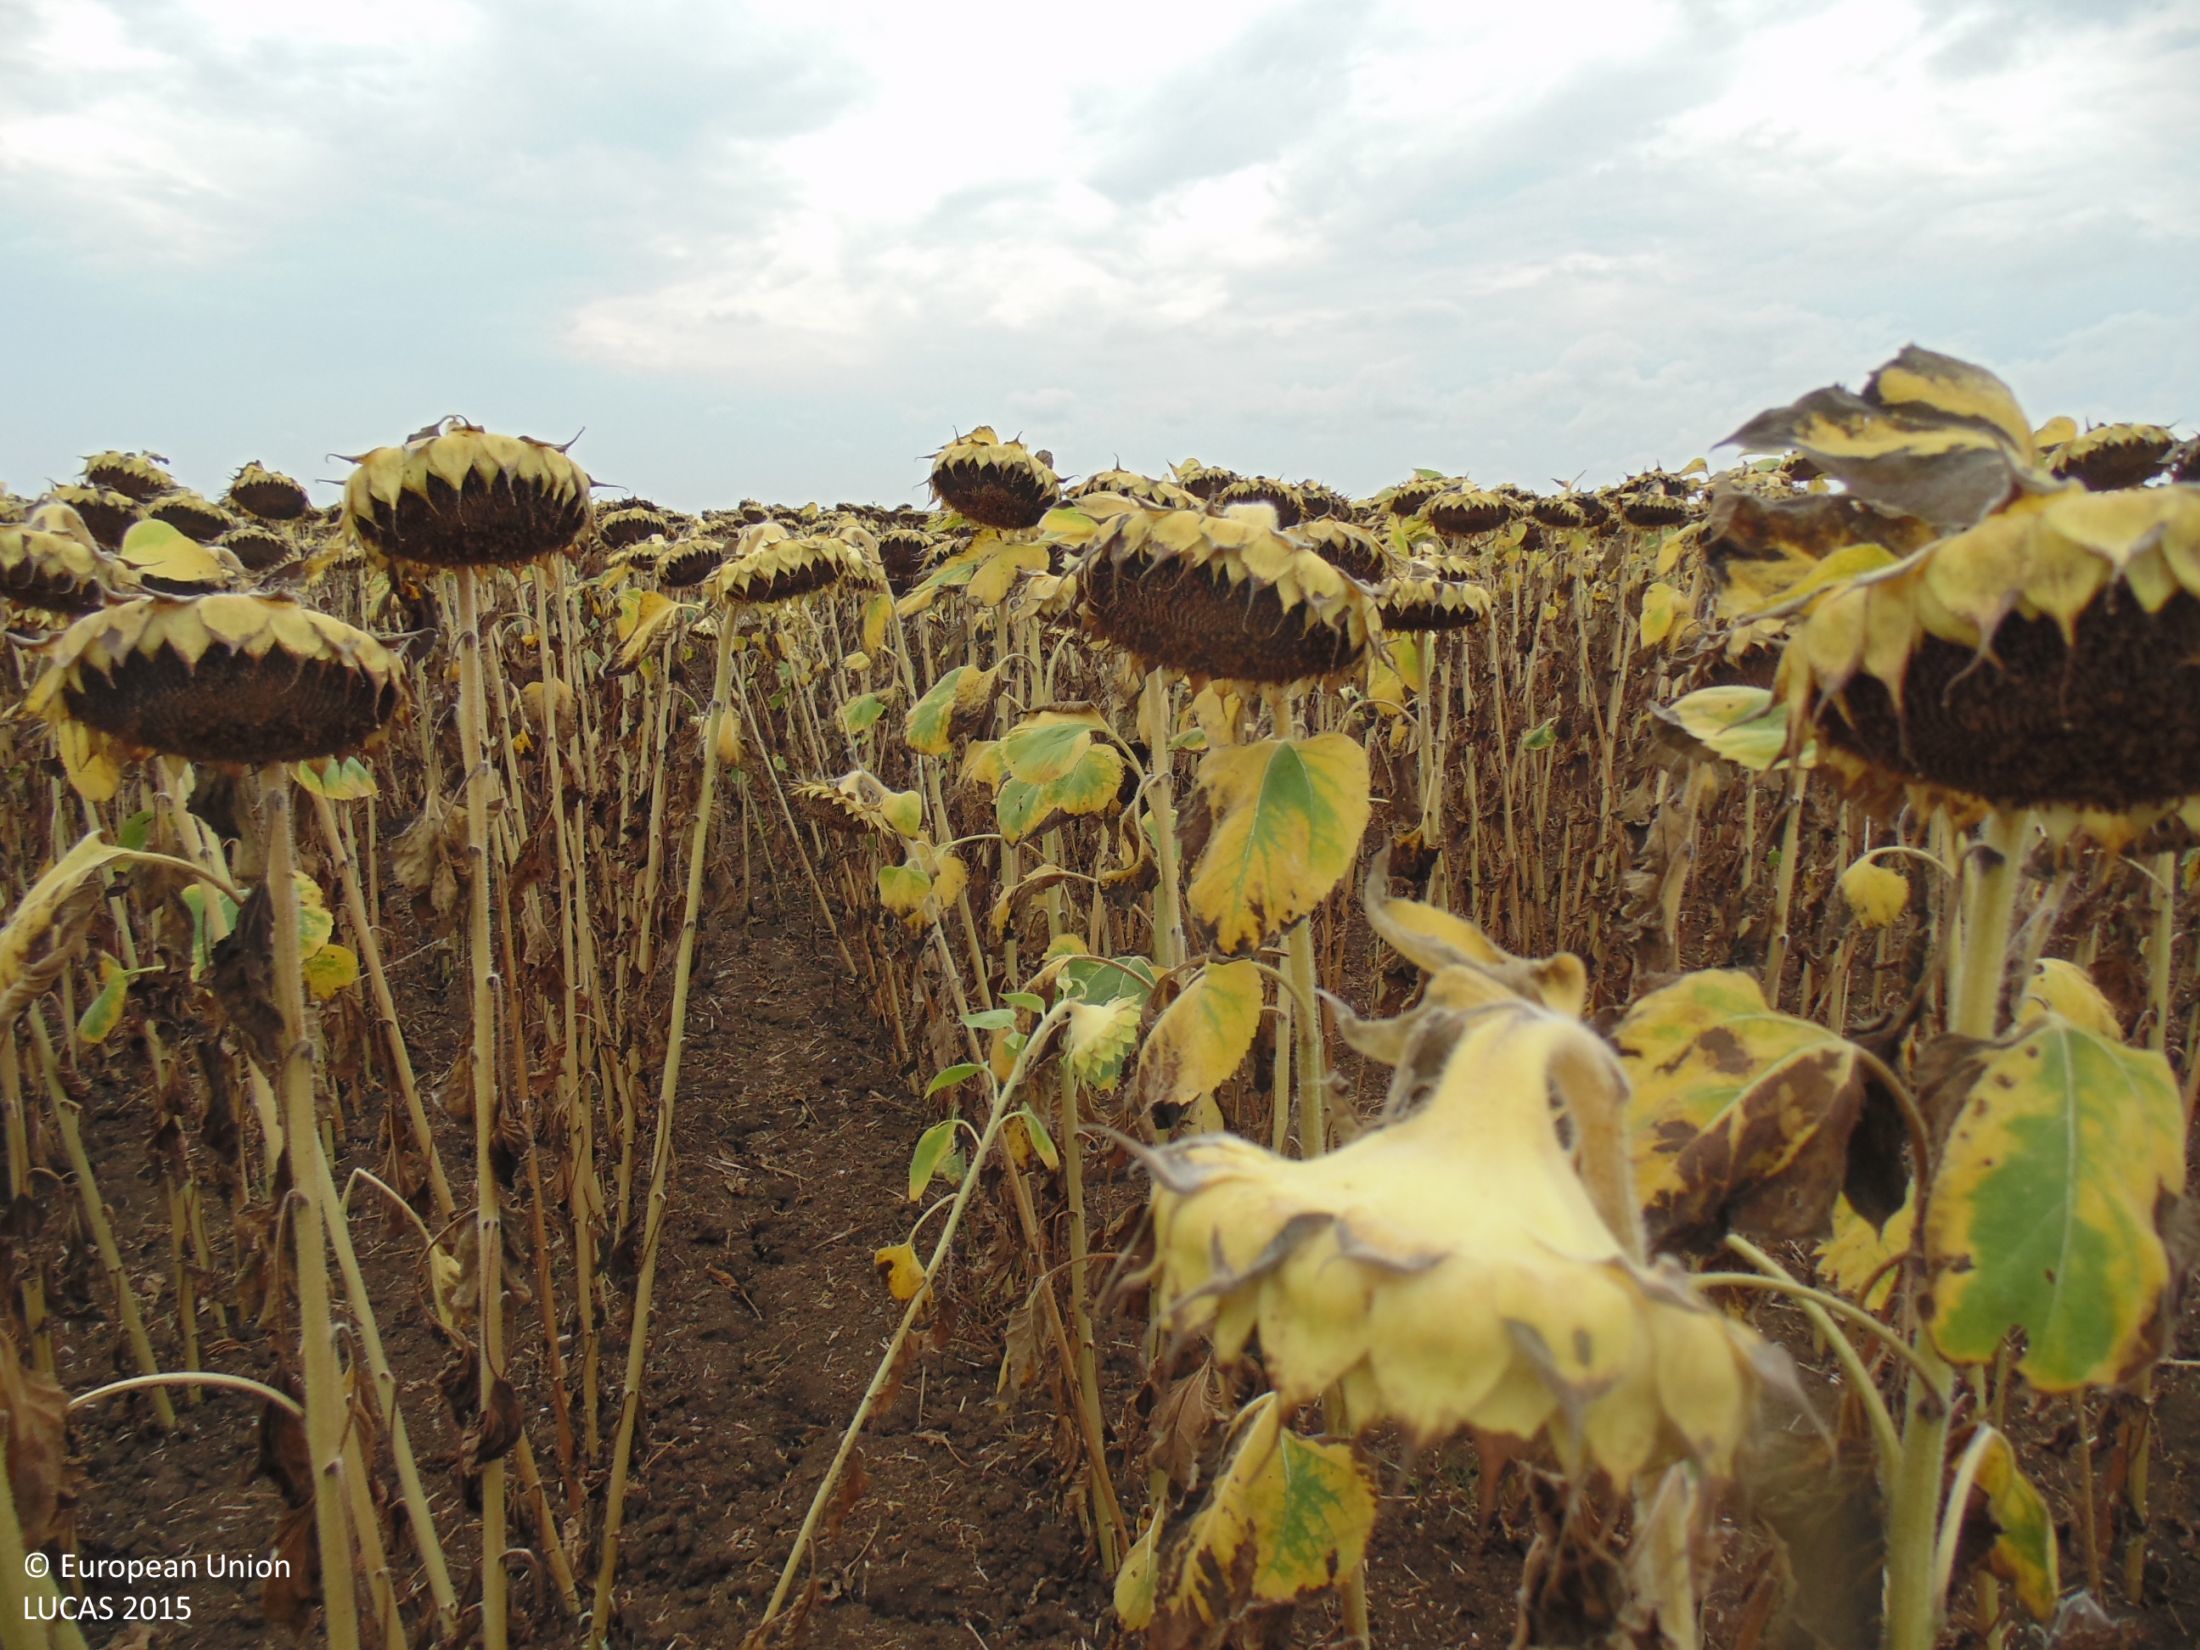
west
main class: Cropland
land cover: Sunflower
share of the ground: > 75 %
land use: Agriculture (excluding fallow land and kitchen gardens)
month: August
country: BG
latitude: 43.5999
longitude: 28.5603
